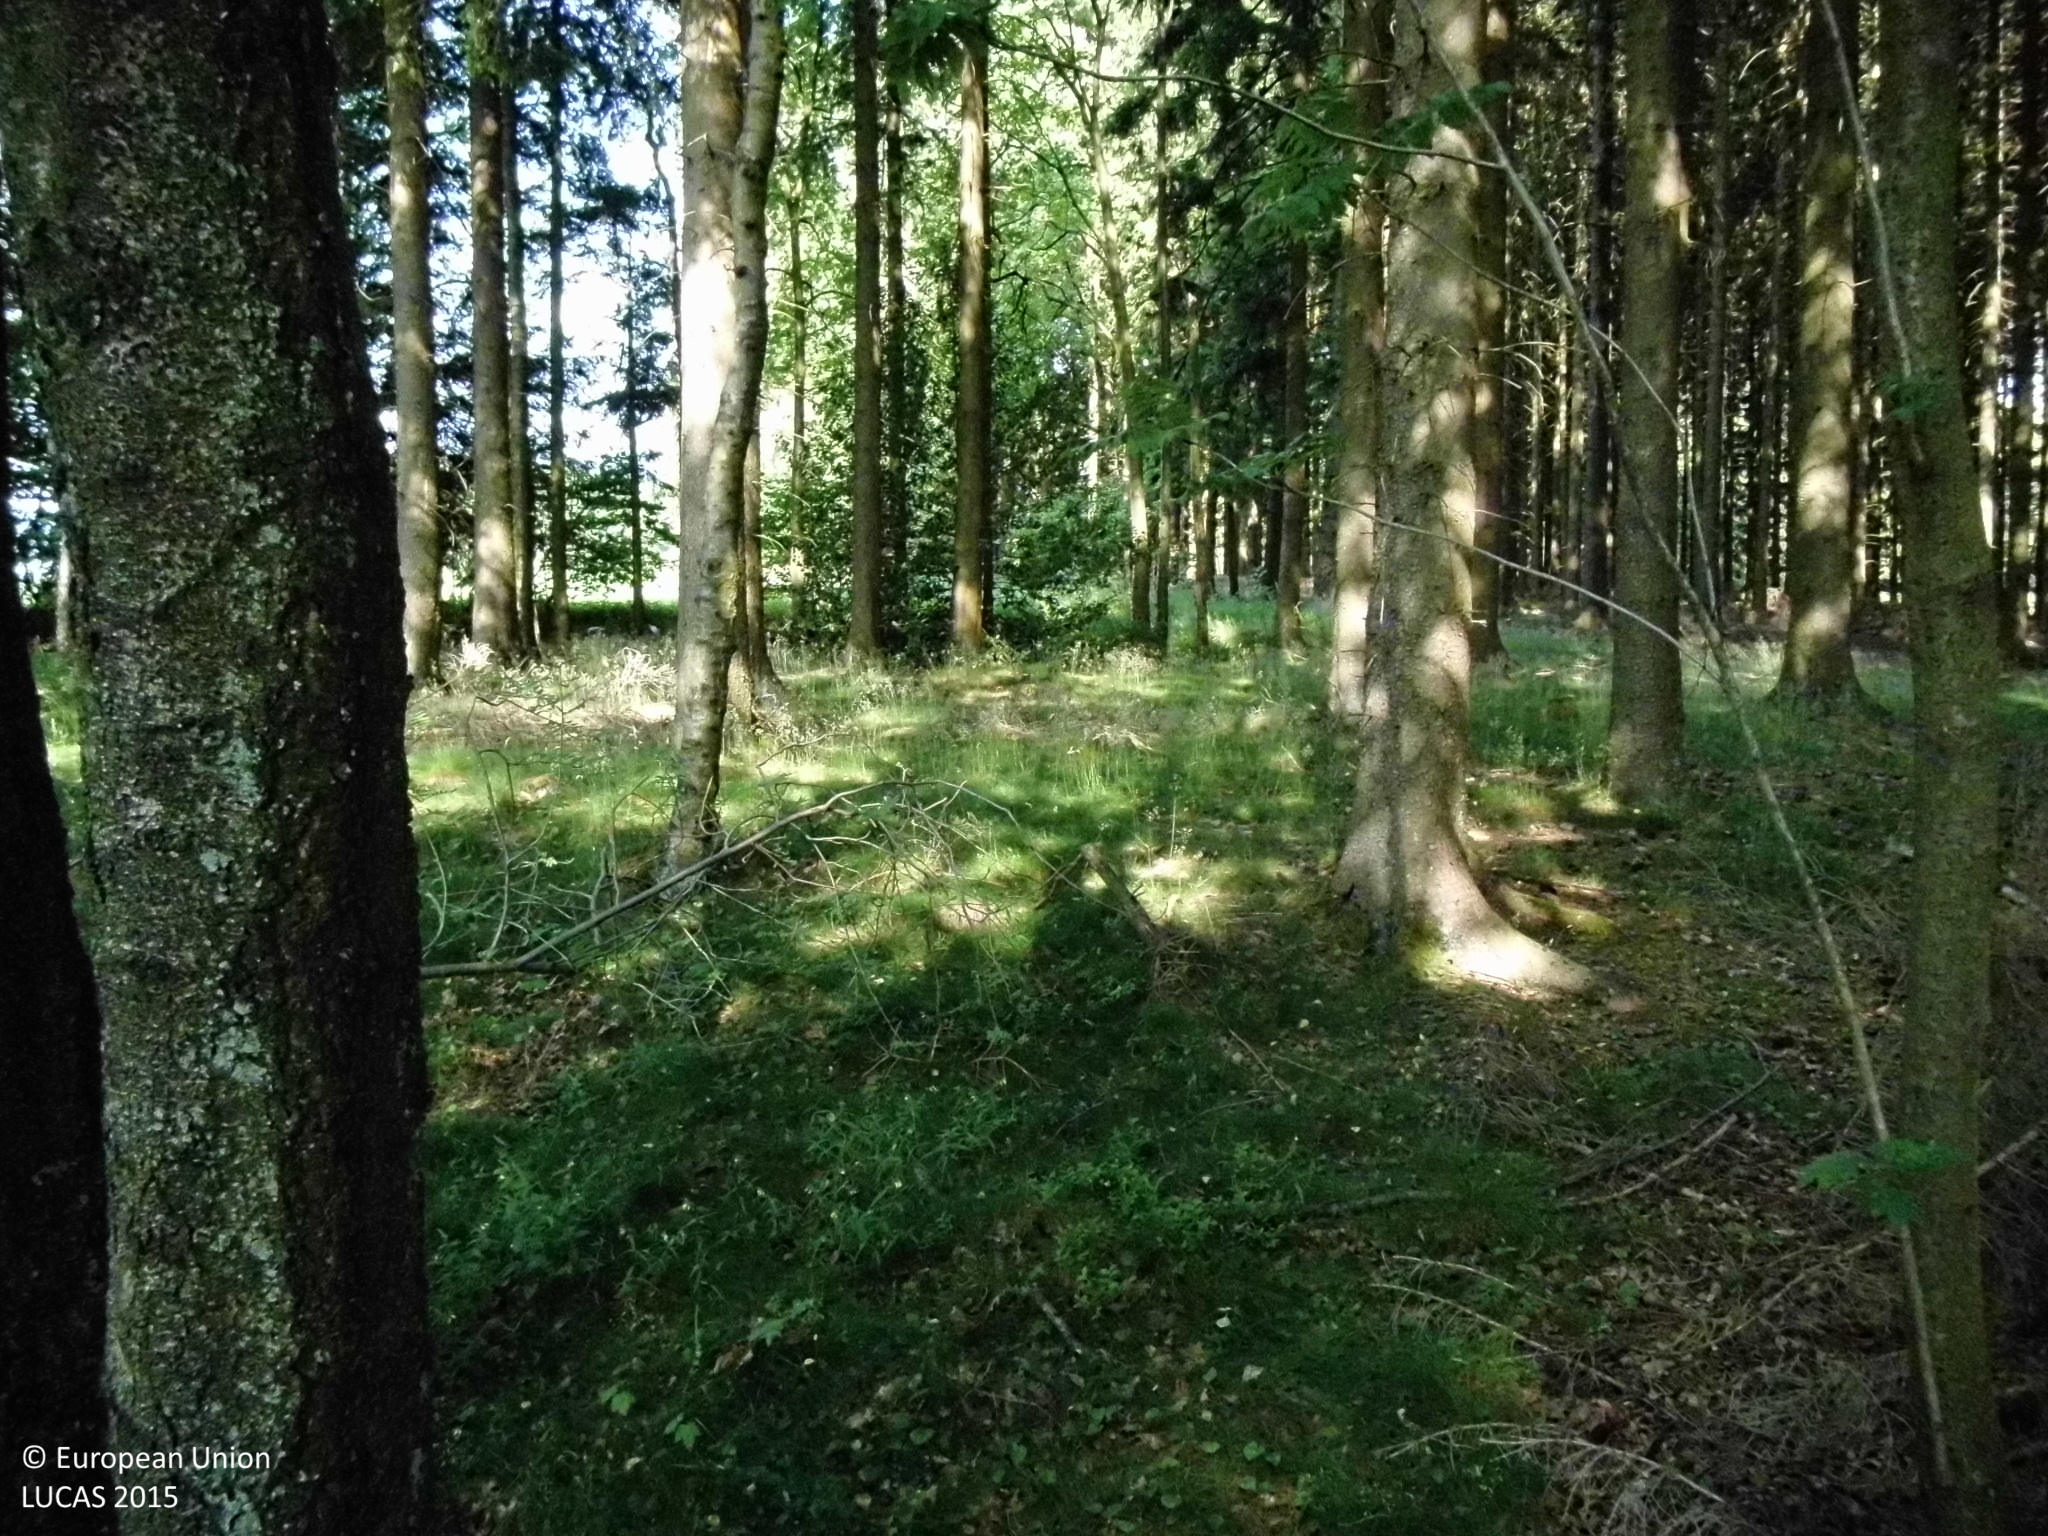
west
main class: Woodland
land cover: Broadleaved woodland
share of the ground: > 75 %
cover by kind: broadleaved forest trees 95 %, herbaceous plants 5 %
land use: Forestry
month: July
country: DE
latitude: 51.2455
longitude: 7.9804
